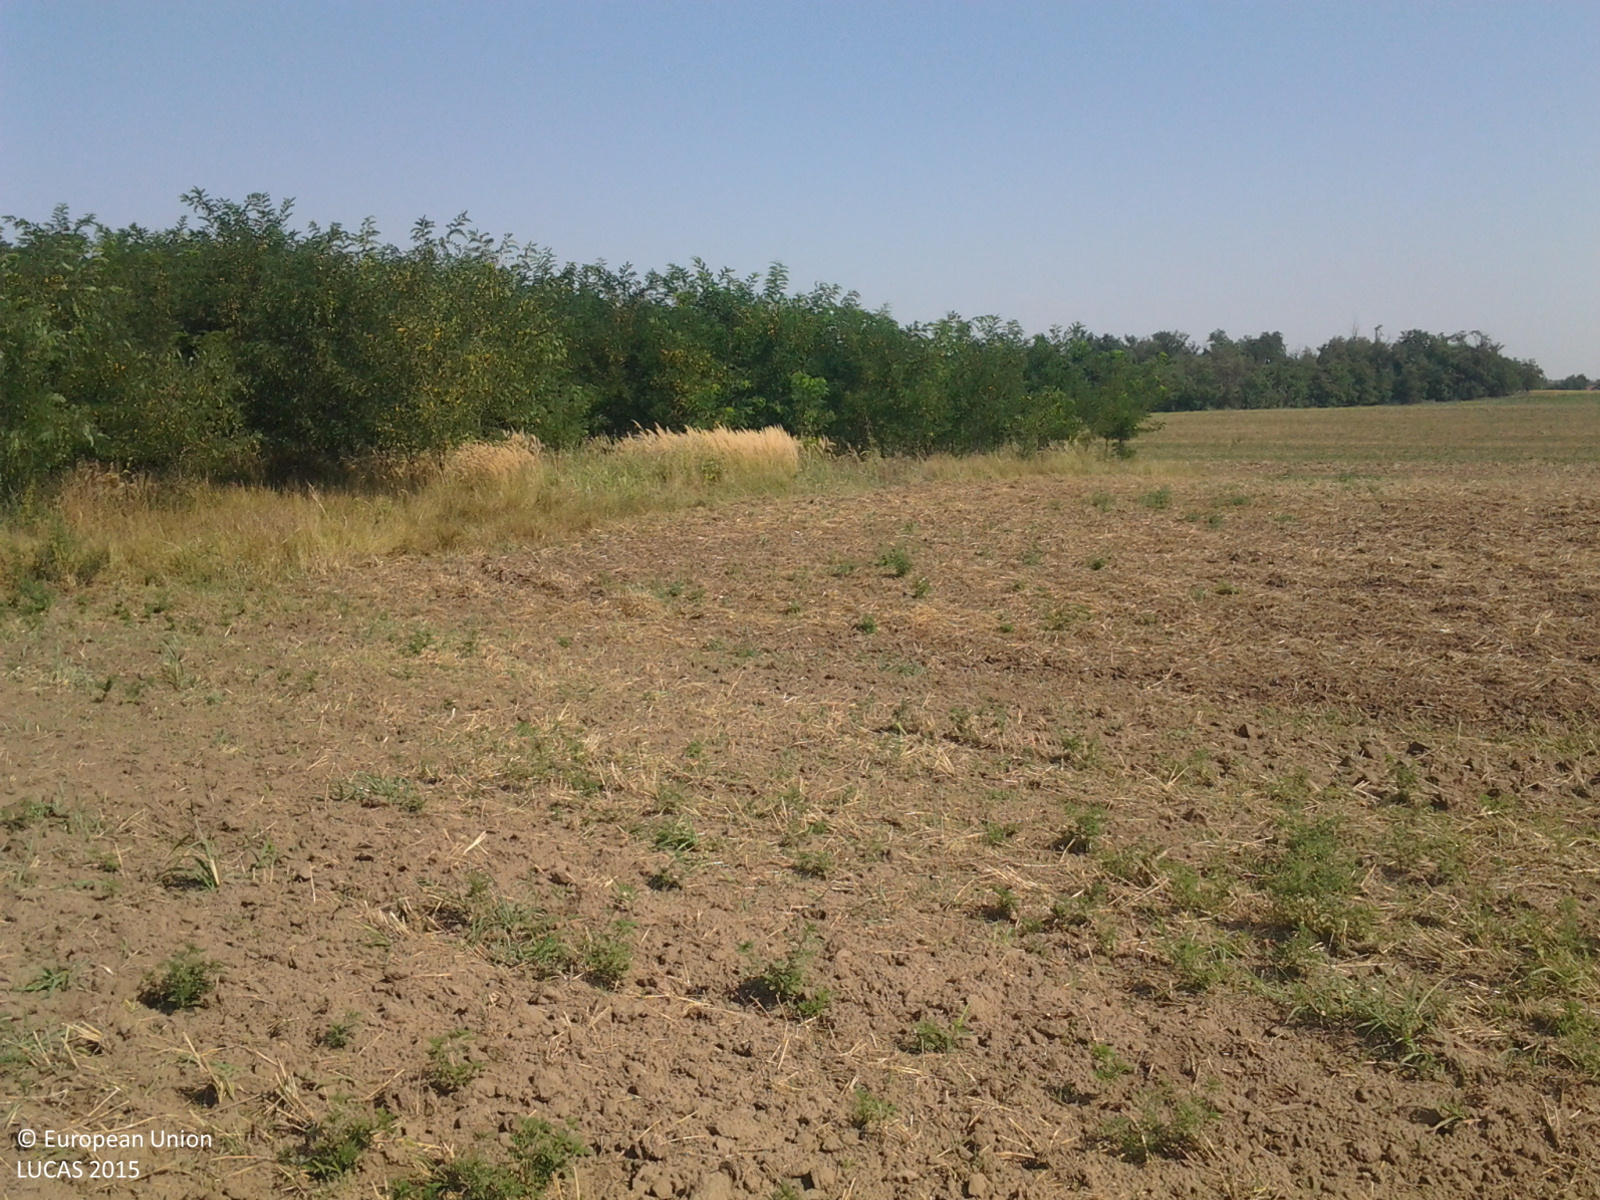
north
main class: Cropland
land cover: Barley
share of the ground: < 10 %
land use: Agriculture (excluding fallow land and kitchen gardens)
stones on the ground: < 10 %
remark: Harvested field
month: August
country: HU
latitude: 47.3633
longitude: 19.8622
